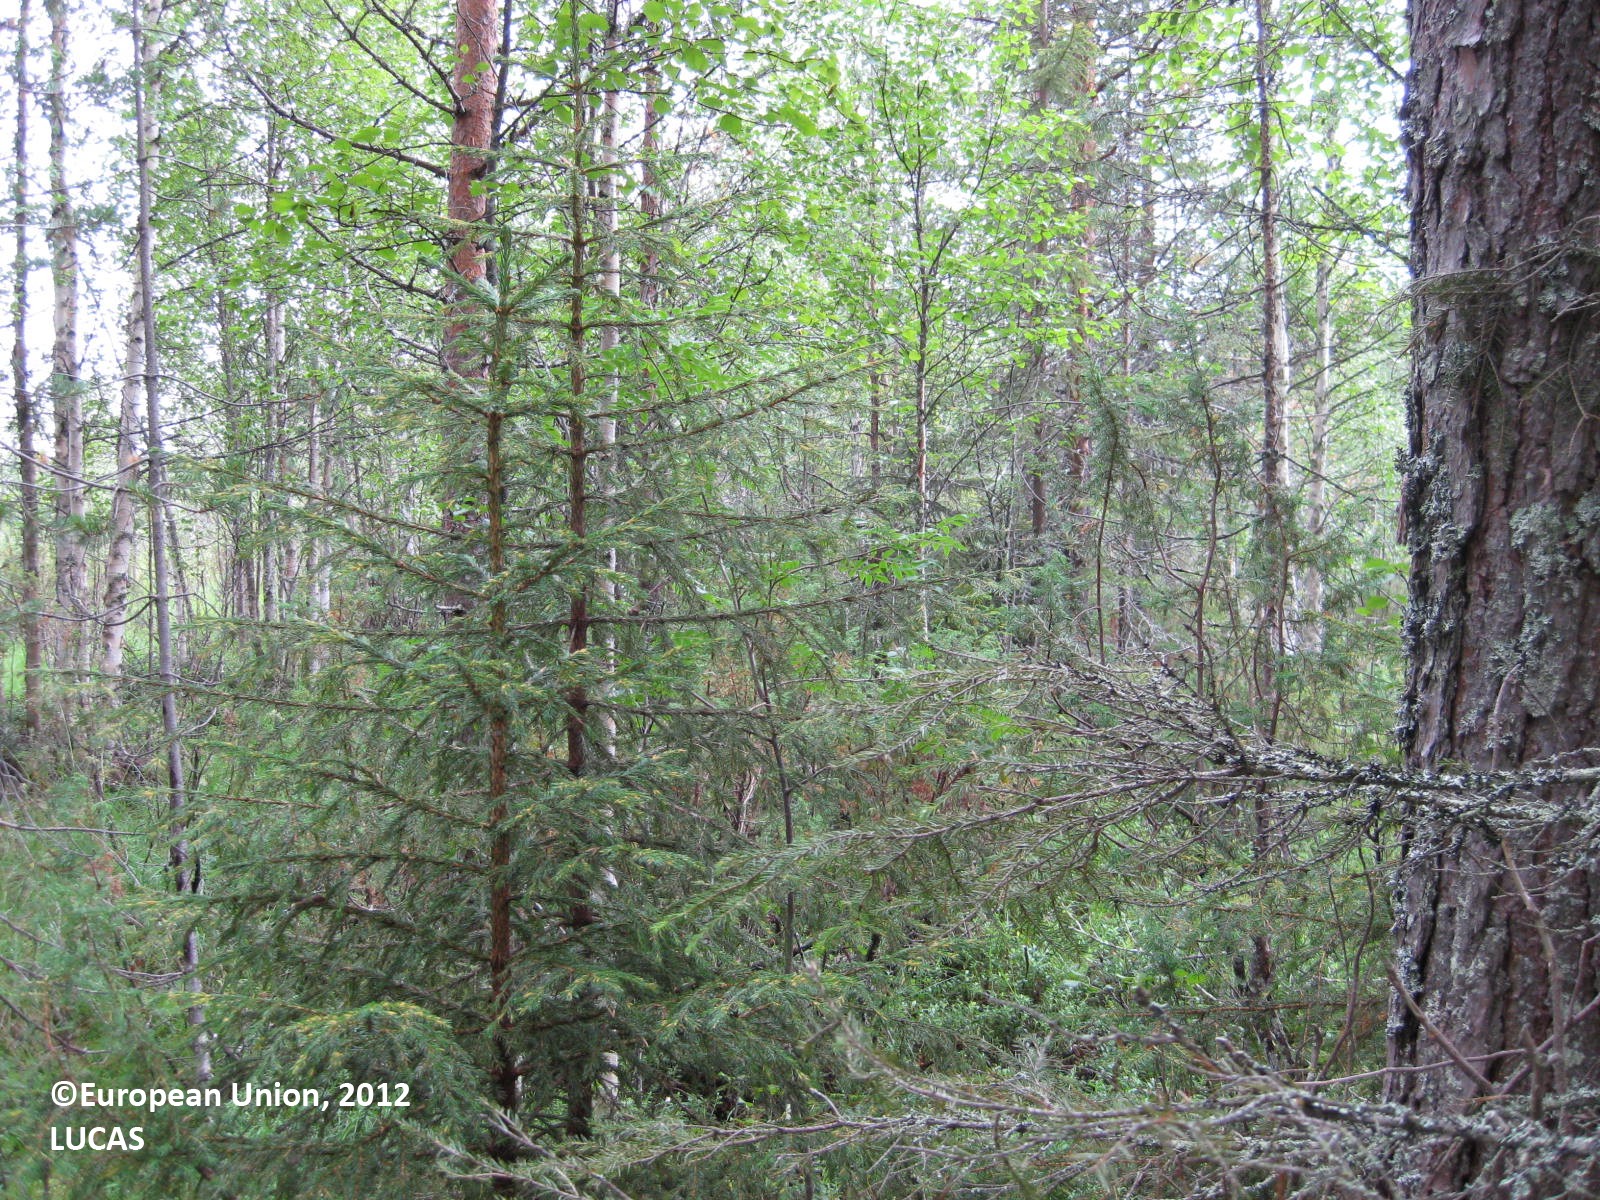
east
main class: Woodland
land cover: Pine dominated mixed woodland
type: boreal forest
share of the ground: > 75 %
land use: Forestry
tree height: > 5 m
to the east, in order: Pine dominated mixed woodland; Ditches and canals; Pine dominated mixed woodland; Pine dominated coniferous woodland; Ponds and wetlands; Pine dominated coniferous woodland; Ponds and wetlands; Pine dominated coniferous woodland; Ponds and wetlands; Pine dominated coniferous woodland; Ponds and wetlands; Pine dominated coniferous woodland
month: August
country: FI
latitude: 66.0846
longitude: 28.2951
